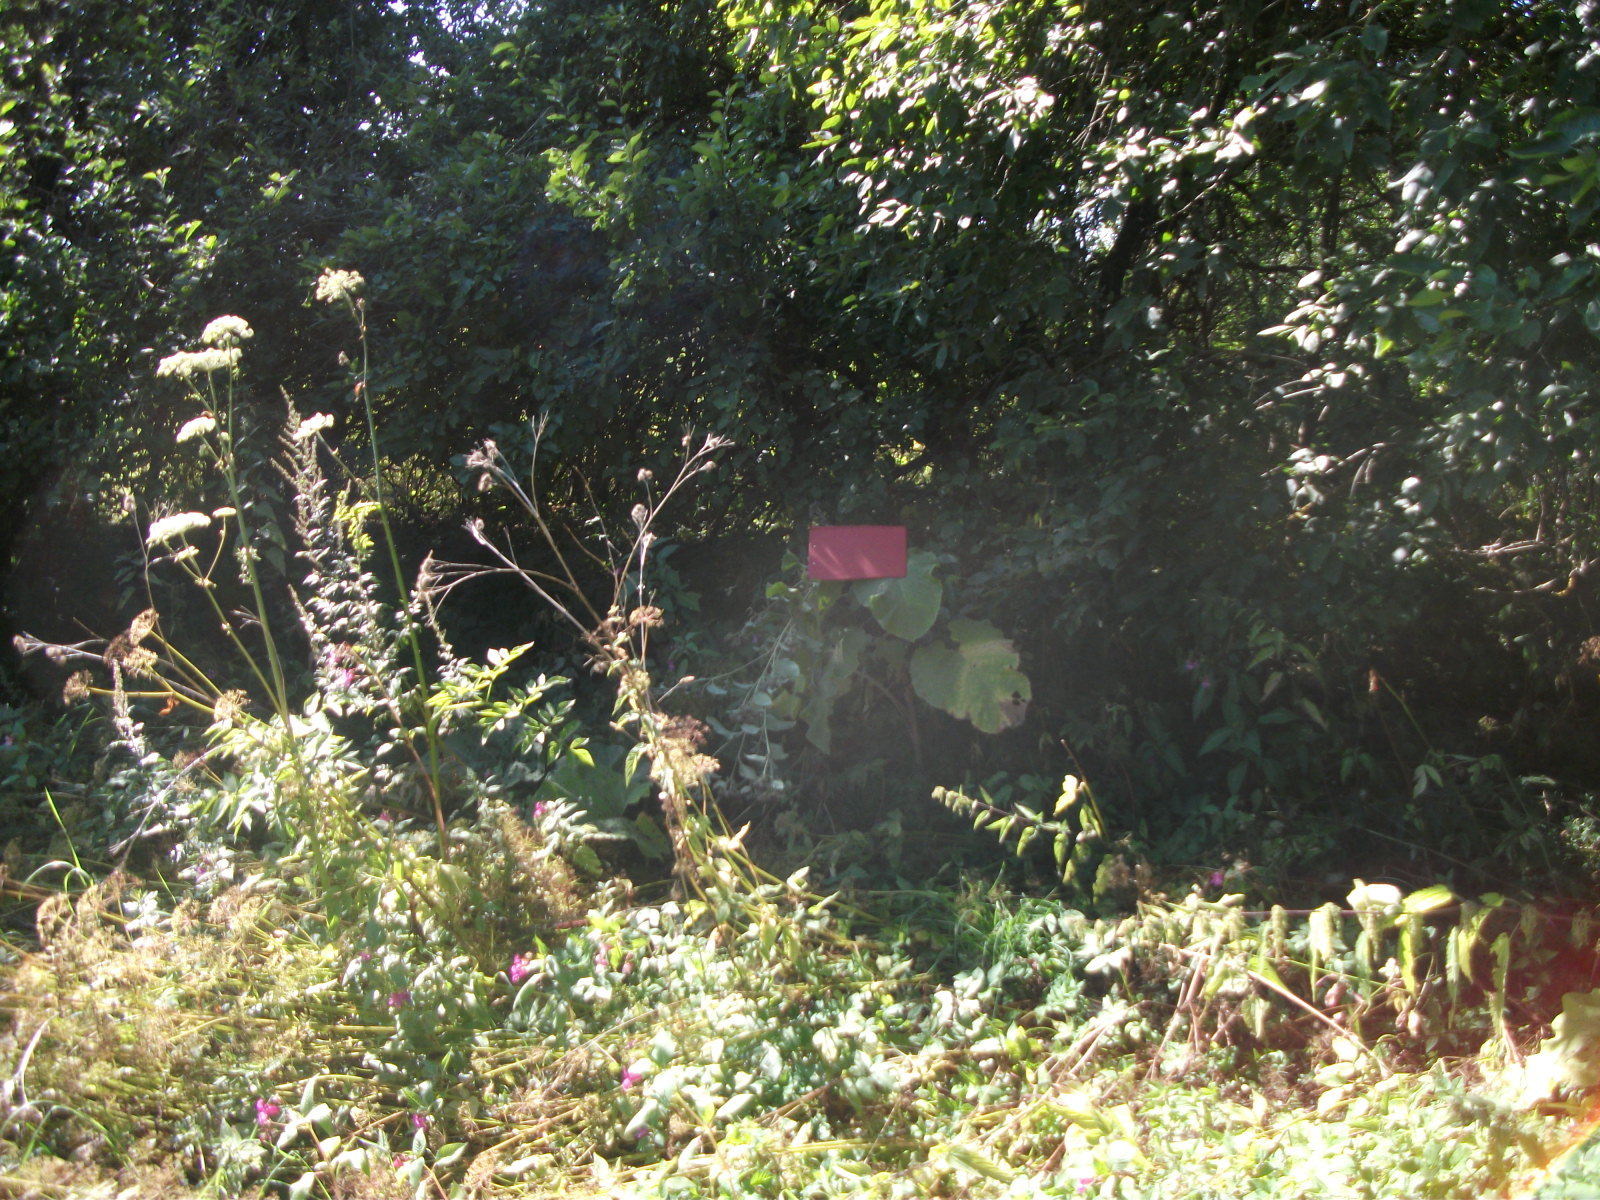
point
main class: Woodland
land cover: Broadleaved woodland
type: non-riverine alder, birch or aspen forest
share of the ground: 50 - 75 %
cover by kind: broadleaved forest trees 60 %, shrubs 20 %, herbaceous plants 20 %
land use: Abandoned areas
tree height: < 5 m
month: August
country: LV
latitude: 56.2619
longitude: 26.4033
